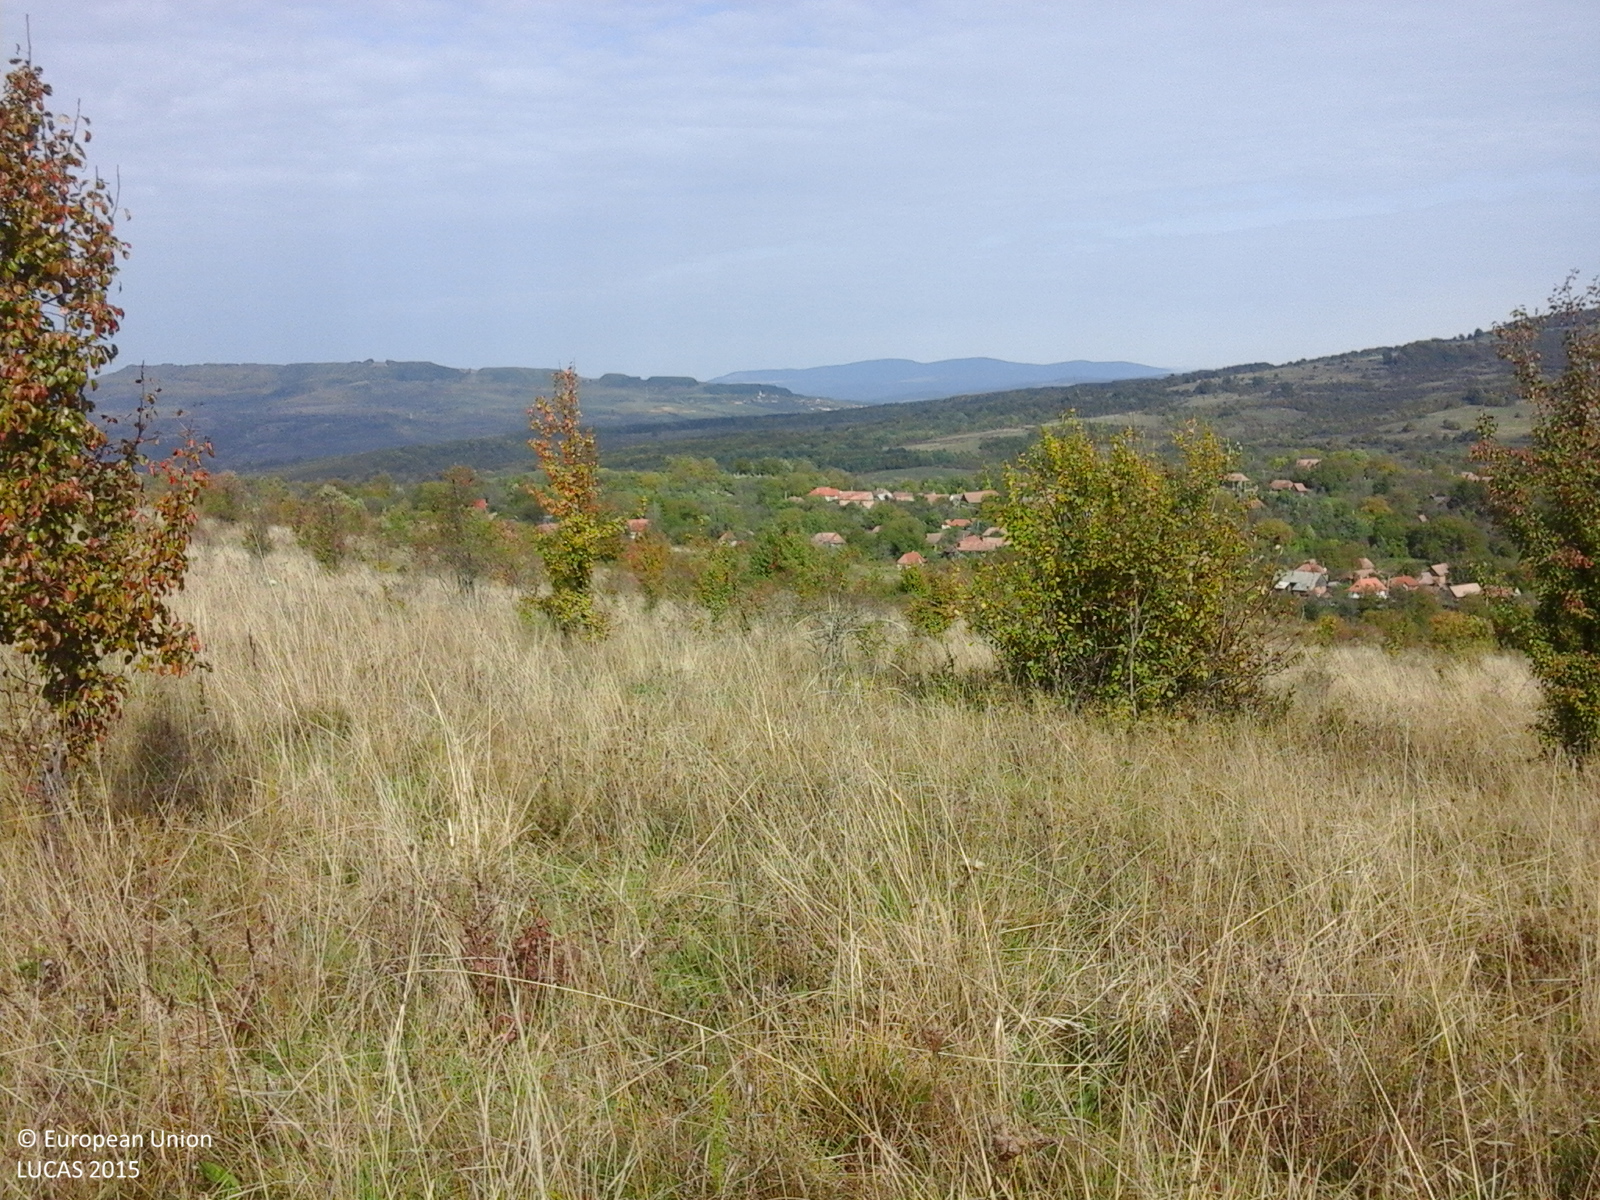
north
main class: Grassland
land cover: Grassland with sparse tree/shrub cover
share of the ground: > 75 %
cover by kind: herbaceous plants 85 %, shrubs 10 %, broadleaved forest trees 5 %
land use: Agriculture (excluding fallow land and kitchen gardens)
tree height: > 5 m
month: October
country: RO
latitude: 46.4247
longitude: 25.1023
